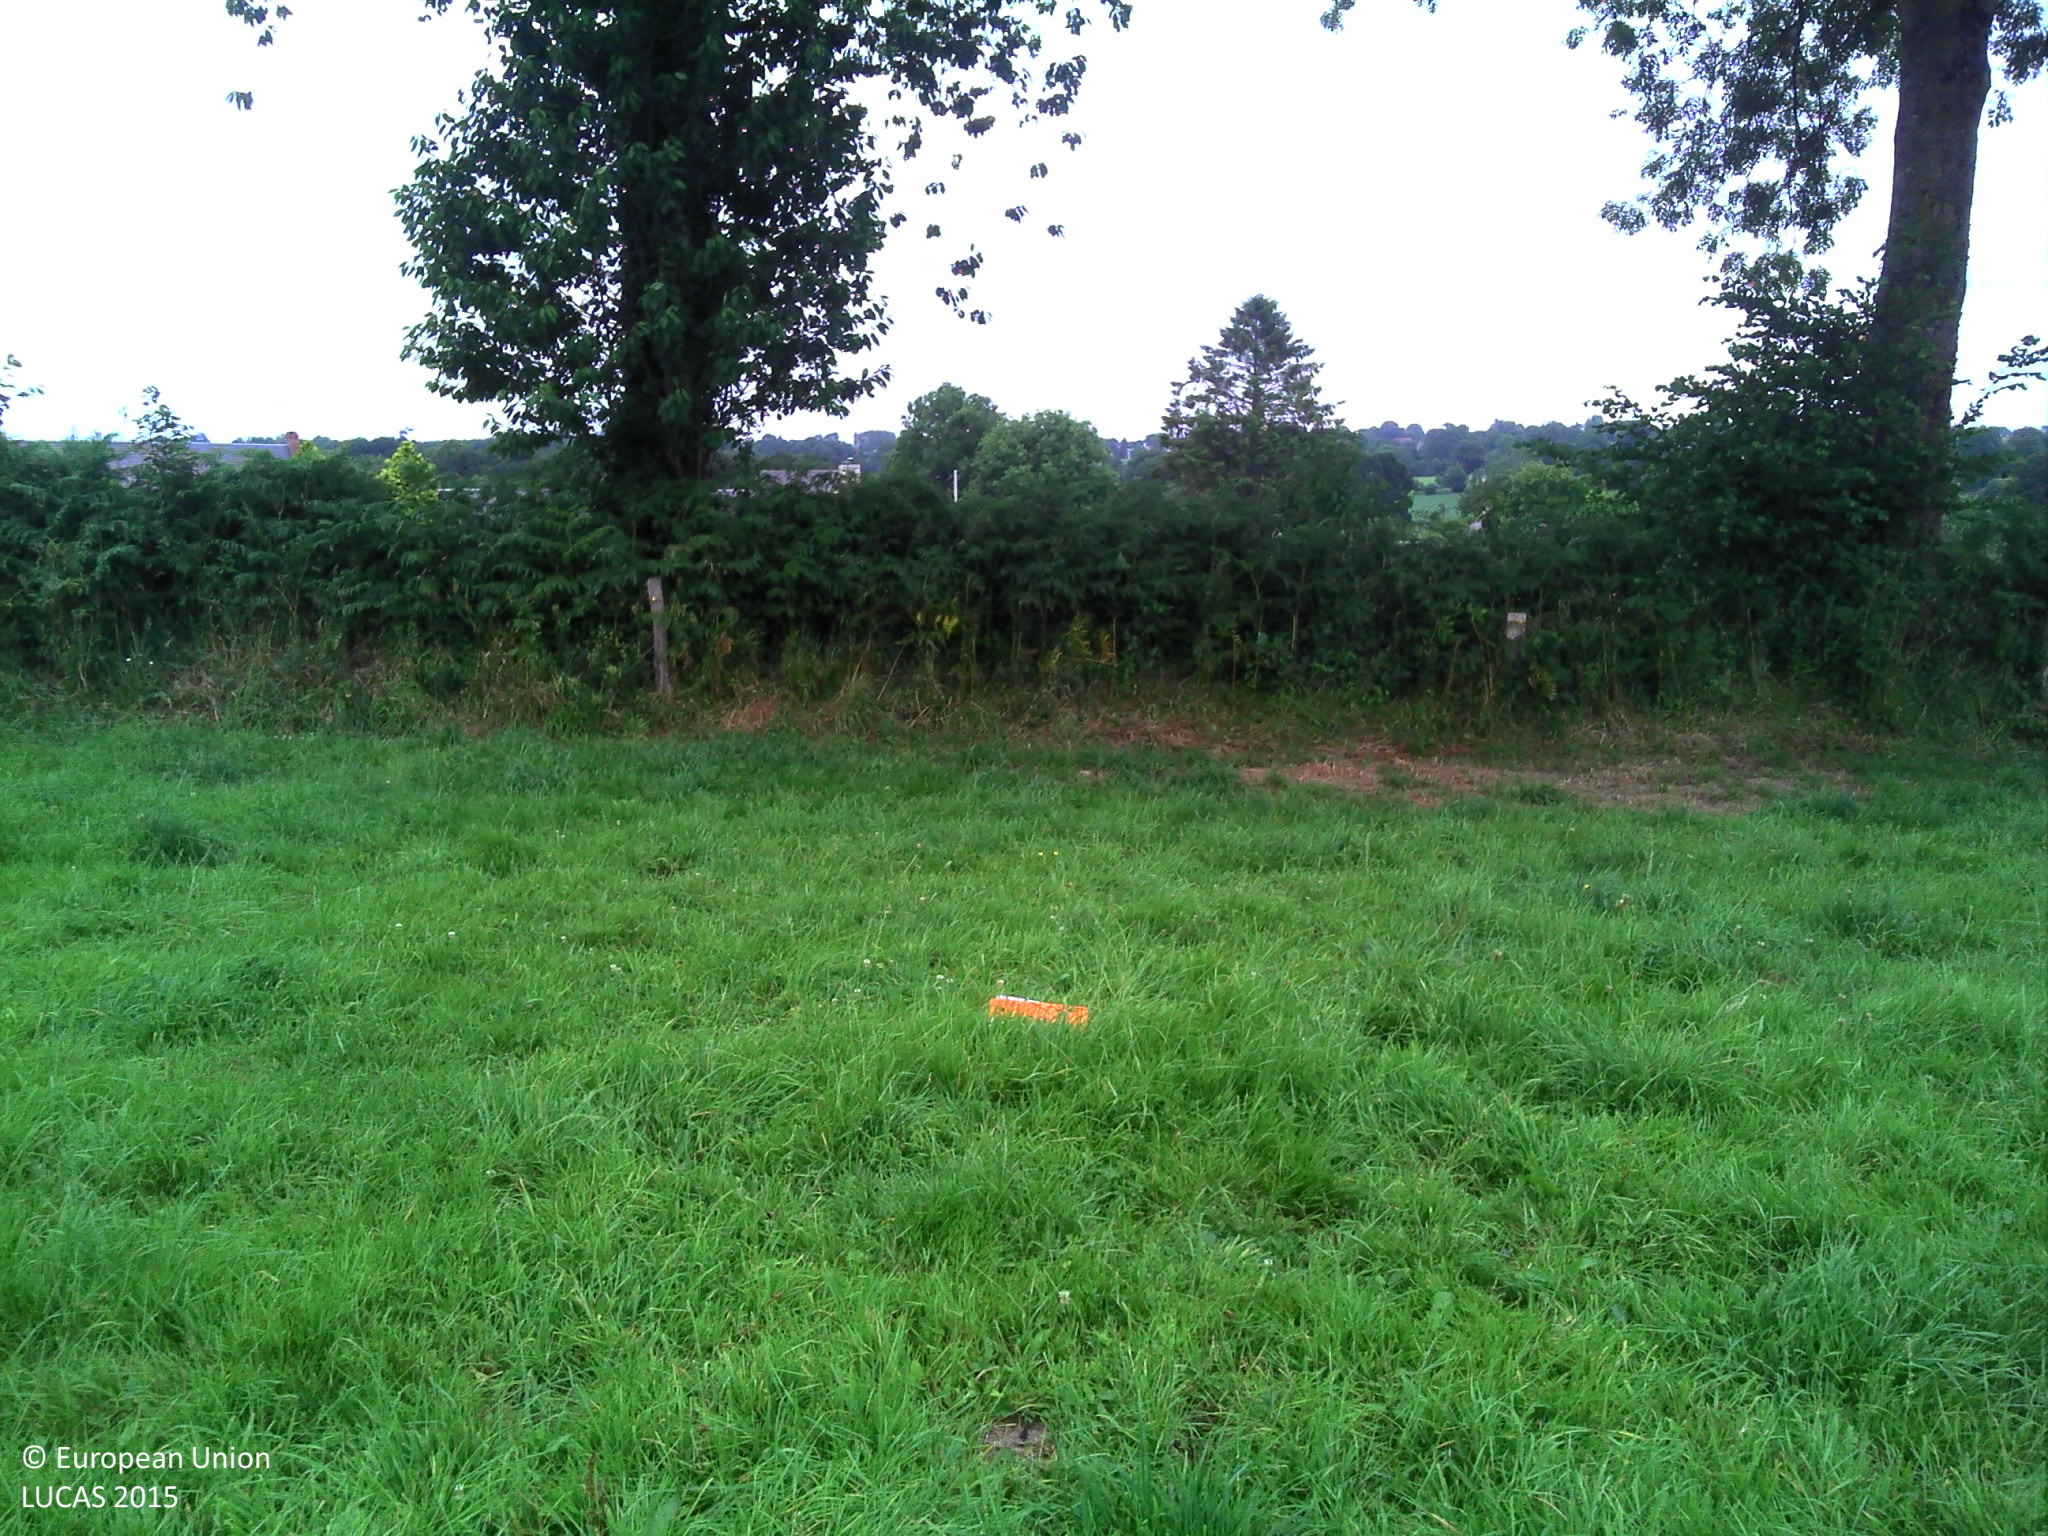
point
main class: Grassland
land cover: Grassland without tree/shrub cover
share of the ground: > 75 %
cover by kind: herbaceous plants 100 %
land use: Agriculture (excluding fallow land and kitchen gardens)
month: July
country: FR
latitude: 48.8298
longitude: -1.3940
